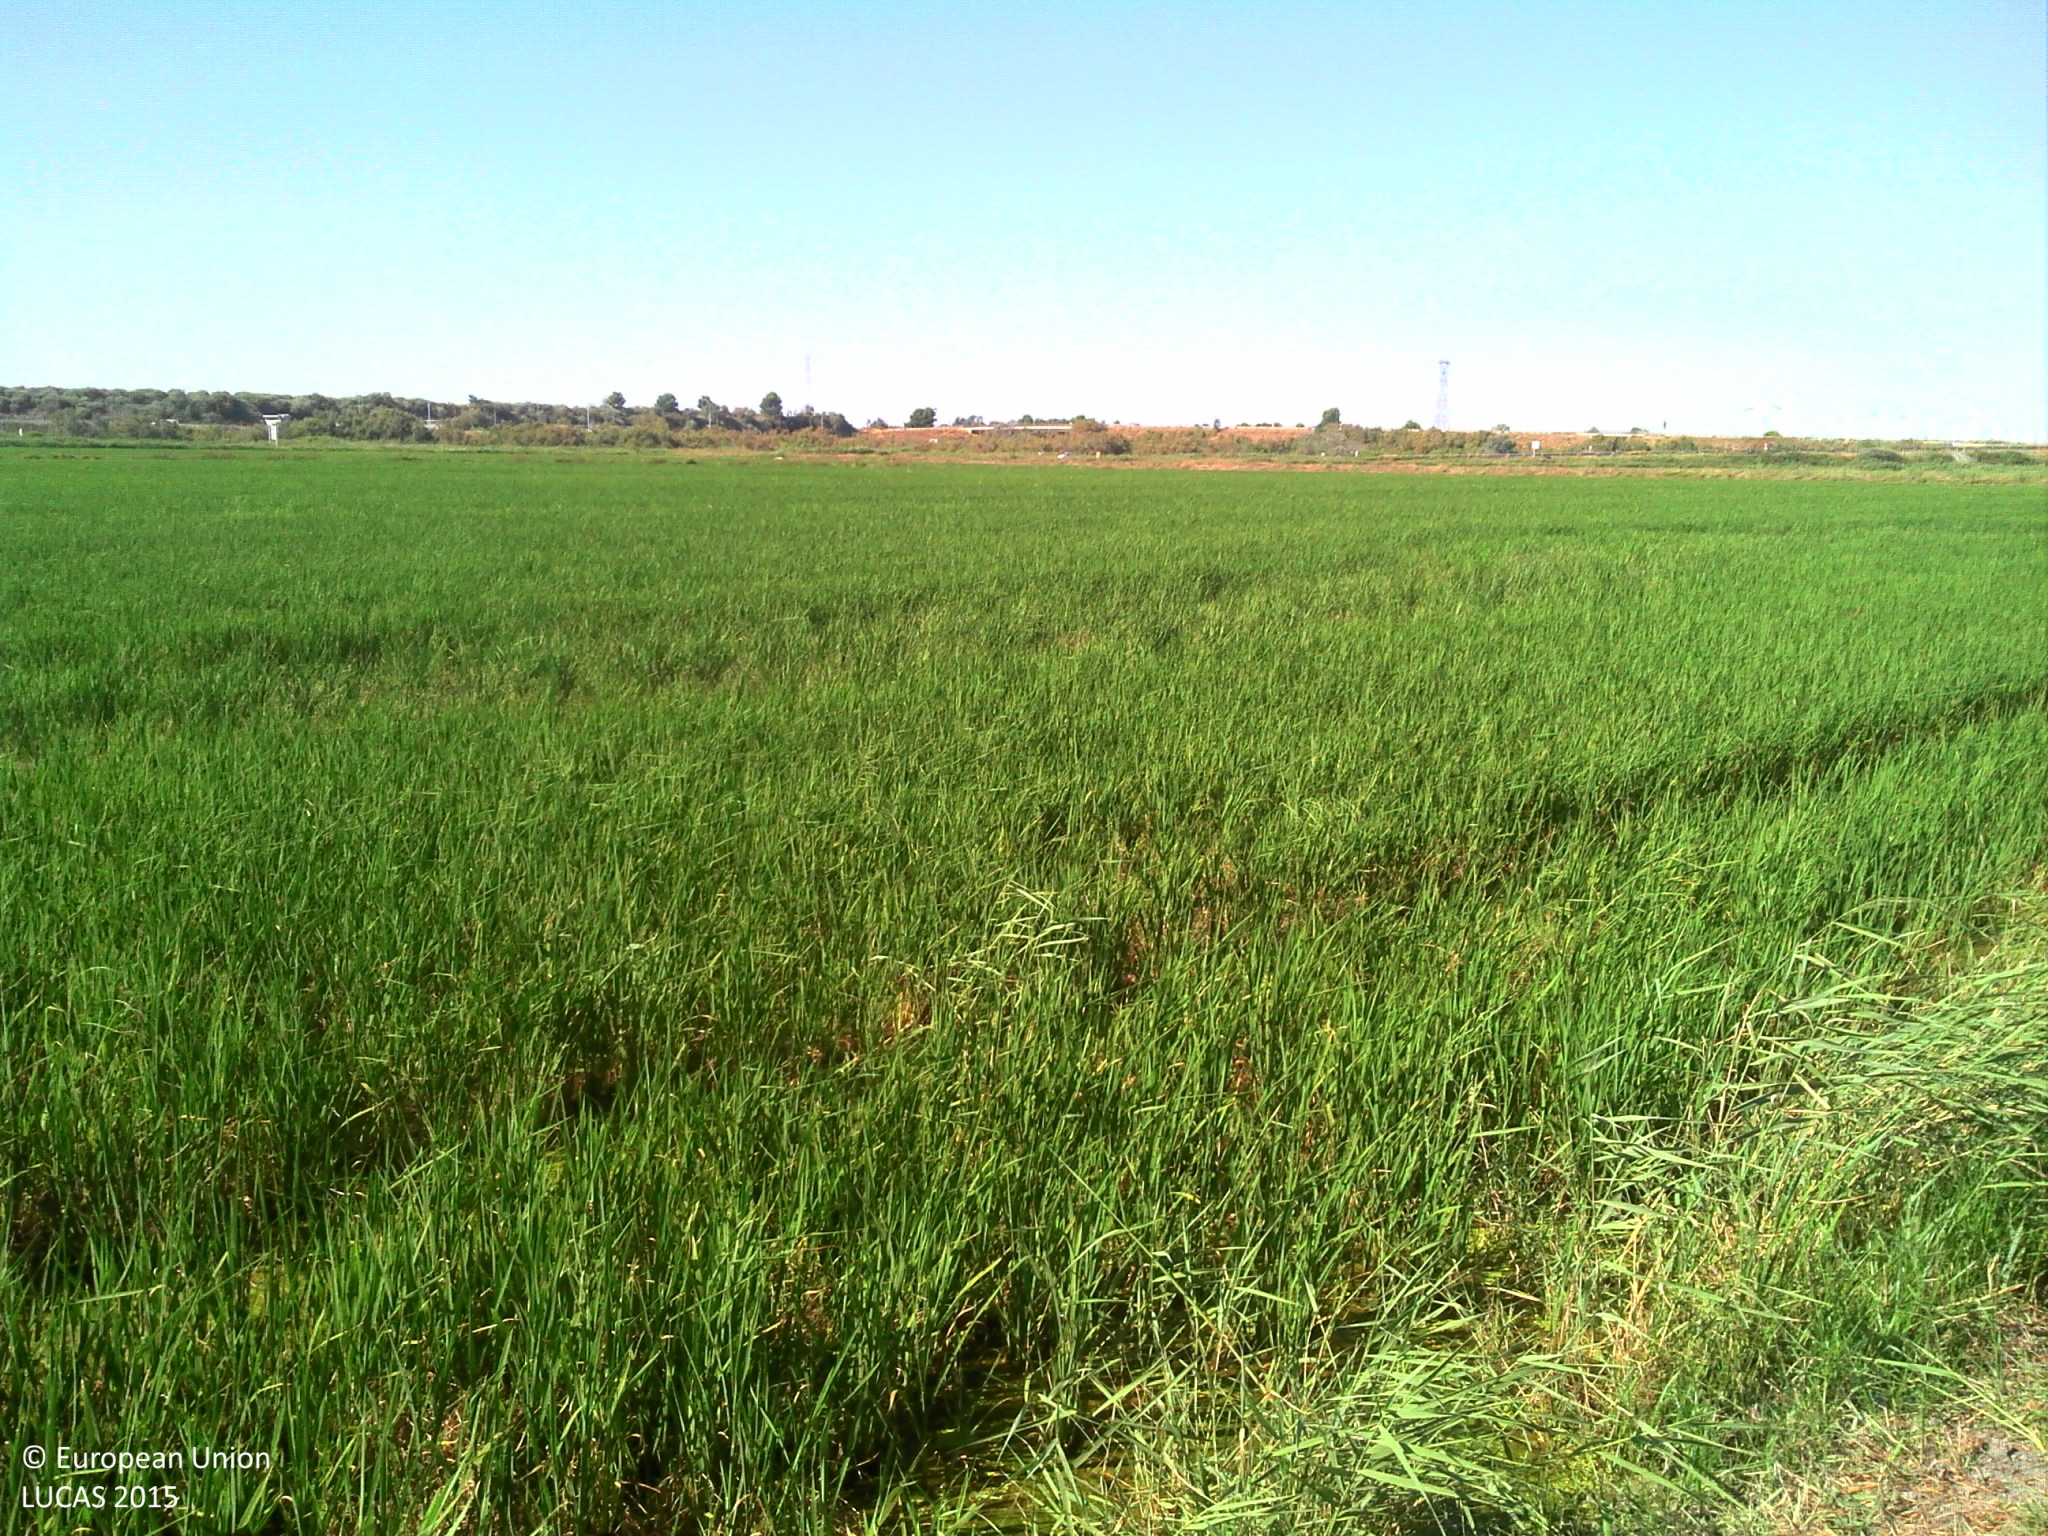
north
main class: Cropland
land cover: Rice
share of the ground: > 75 %
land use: Agriculture (excluding fallow land and kitchen gardens)
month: July
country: FR
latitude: 43.4228
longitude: 4.7608
